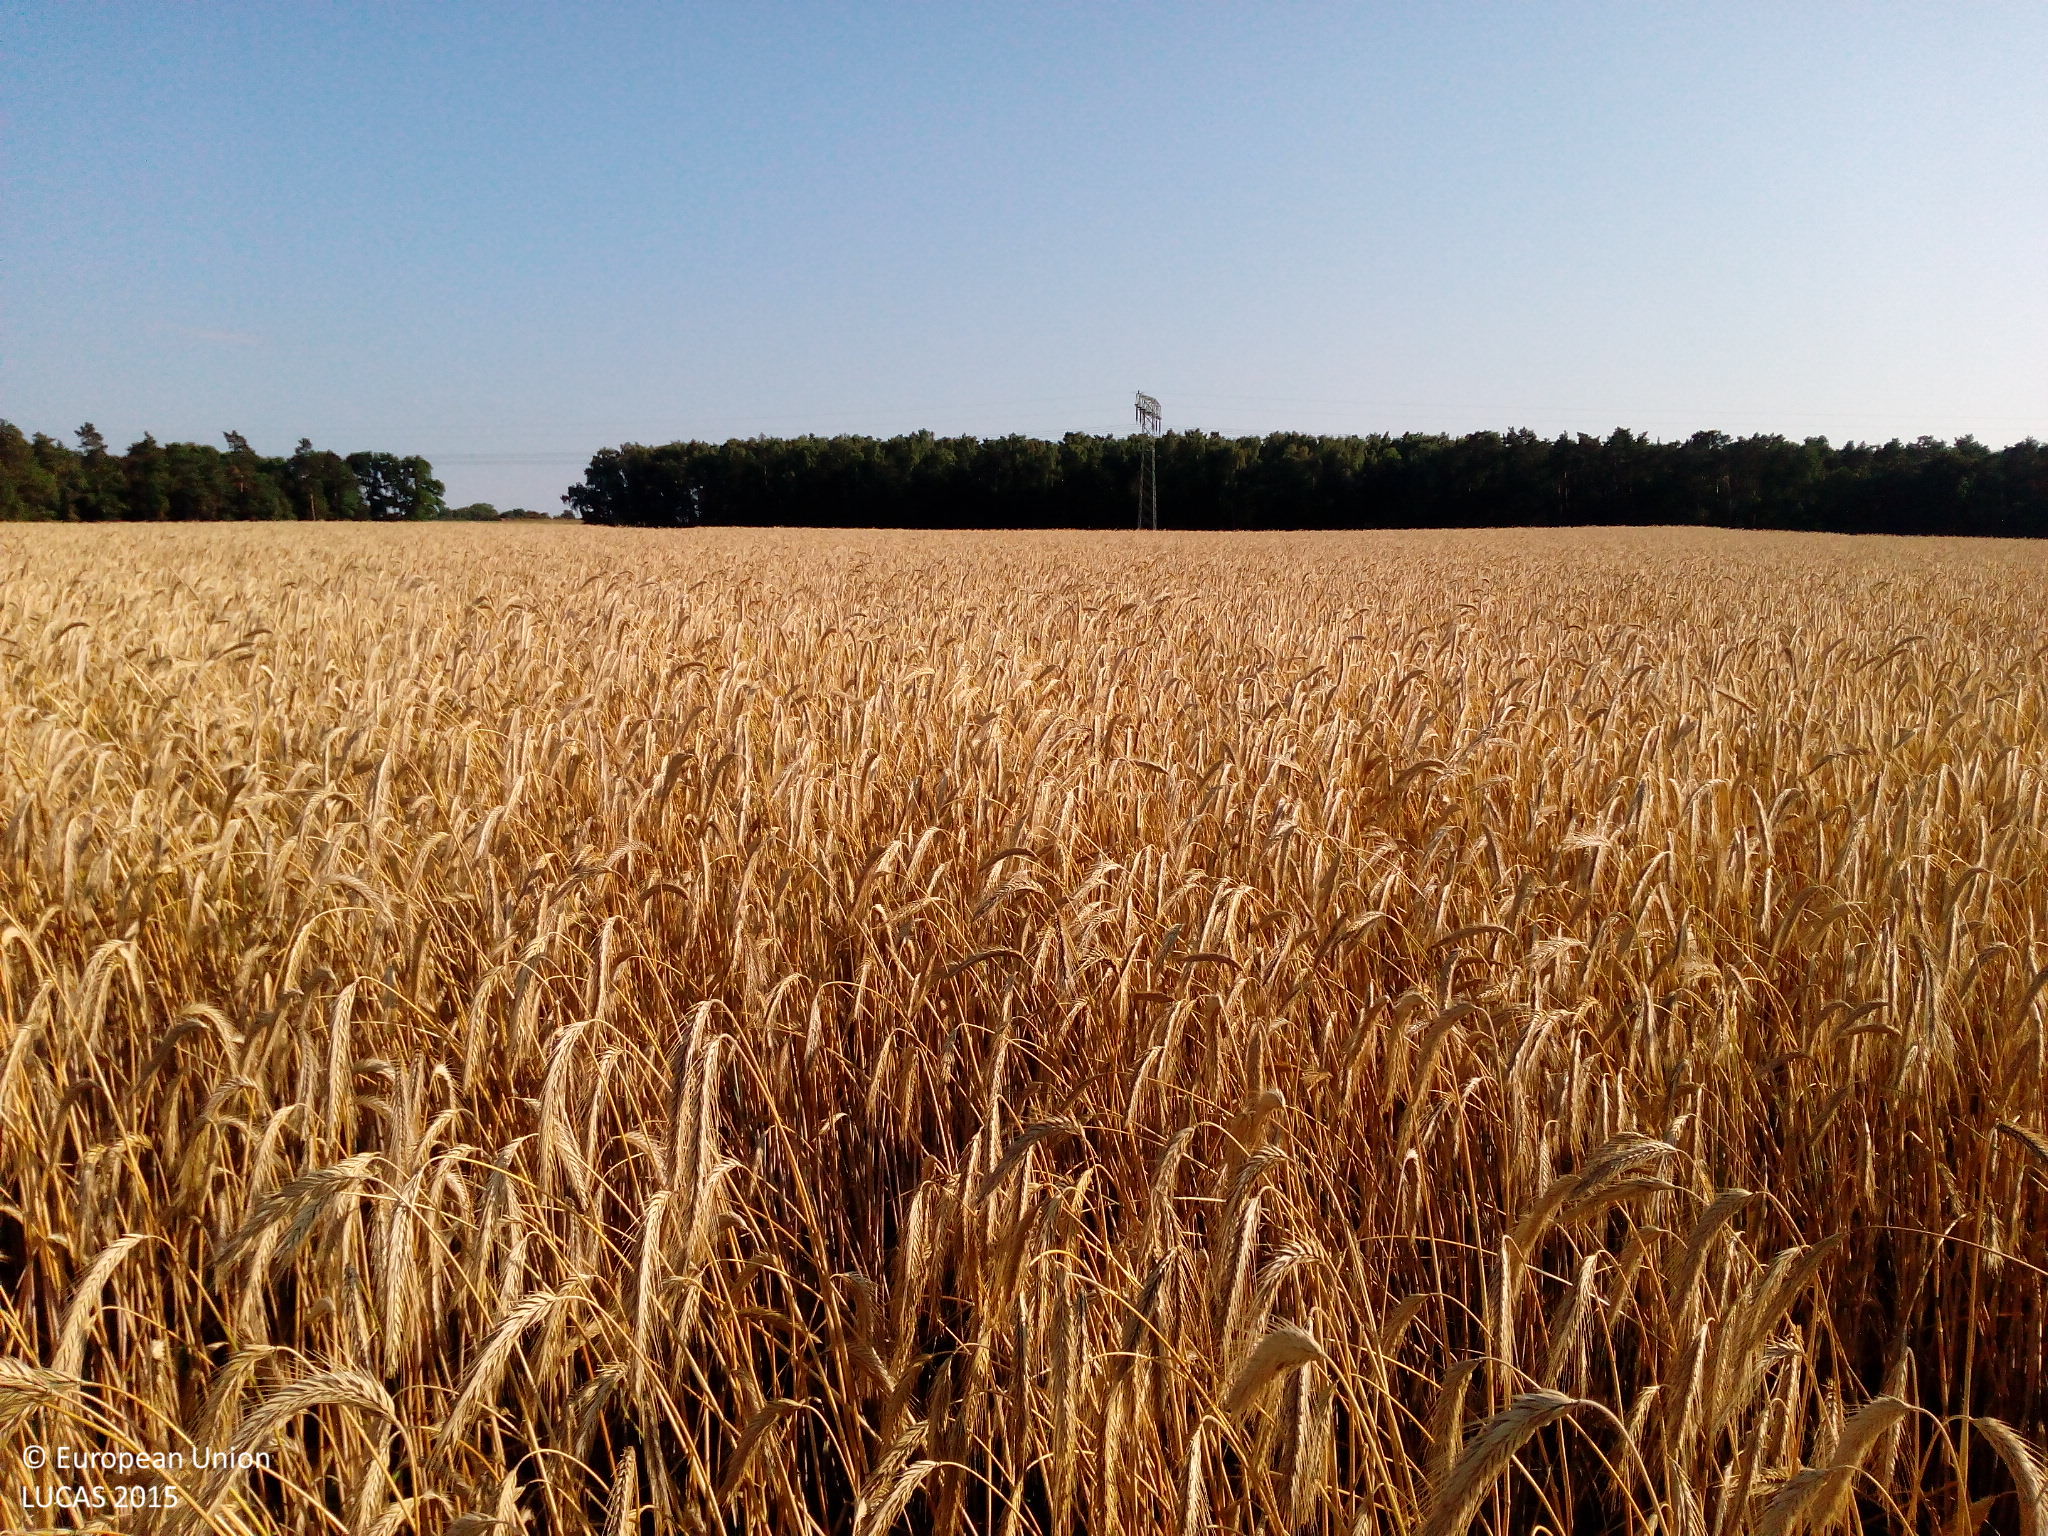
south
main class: Cropland
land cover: Rye
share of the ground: > 75 %
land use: Agriculture (excluding fallow land and kitchen gardens)
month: July
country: DE
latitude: 52.3313
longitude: 14.4185
